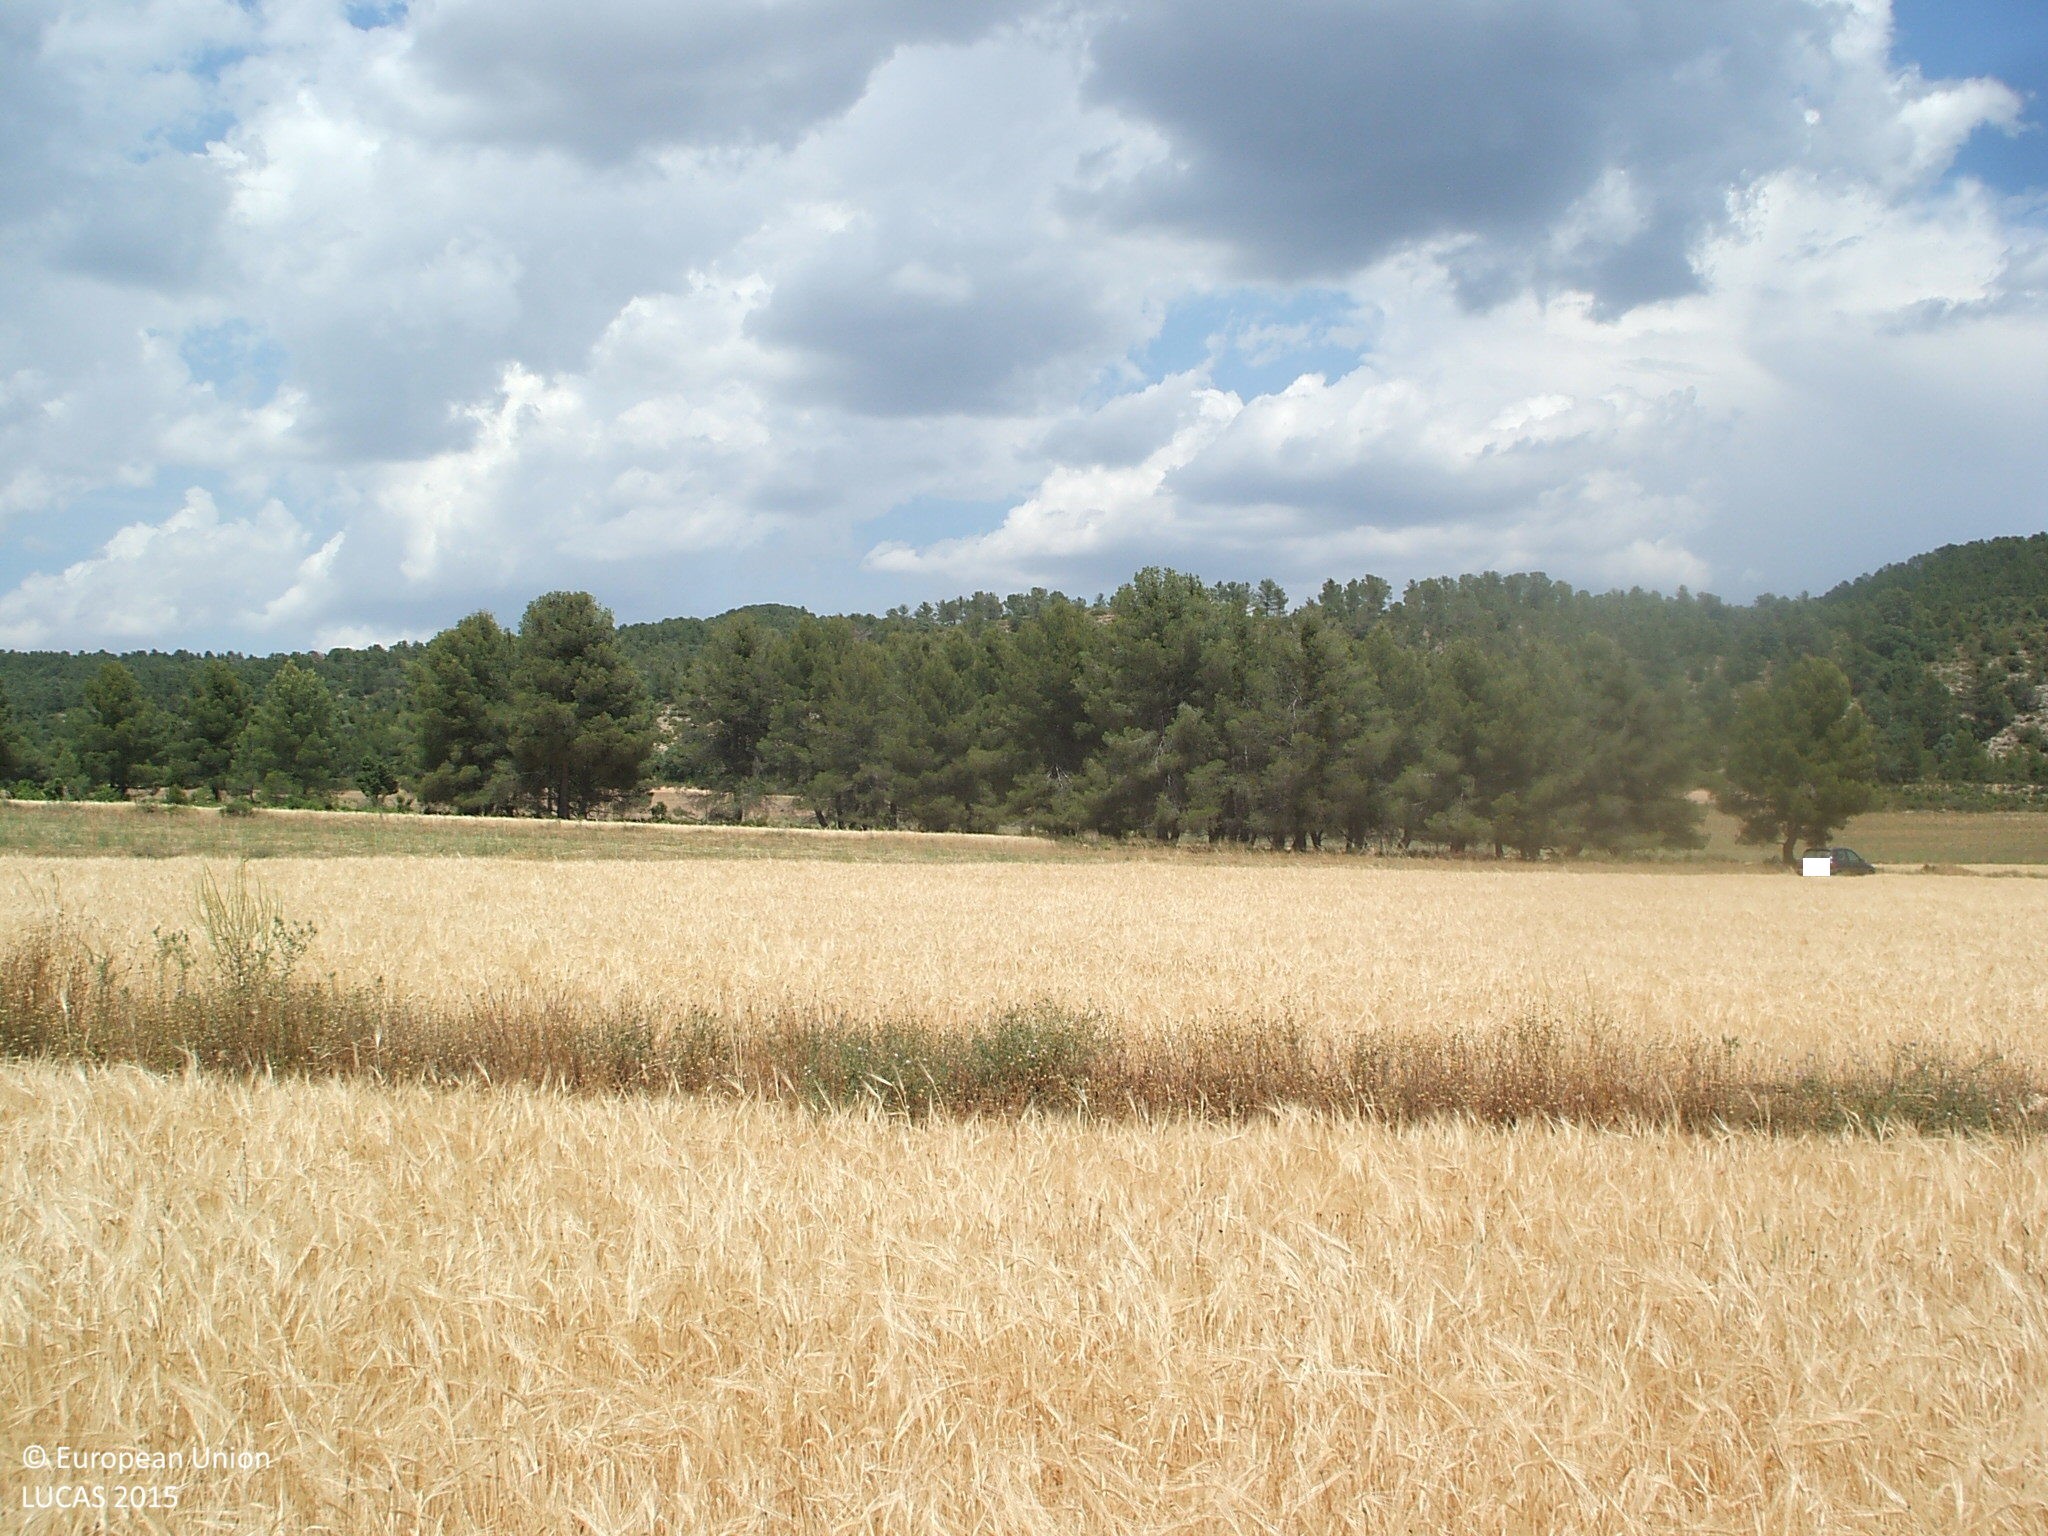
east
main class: Cropland
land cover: Barley
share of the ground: > 75 %
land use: Agriculture (excluding fallow land and kitchen gardens)
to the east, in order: Barley; Grass margins; Barley; Grass margins; Tracks; Grass margins; Barley; Grass margins; Barley
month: June
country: ES
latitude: 40.8148
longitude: -0.1457
